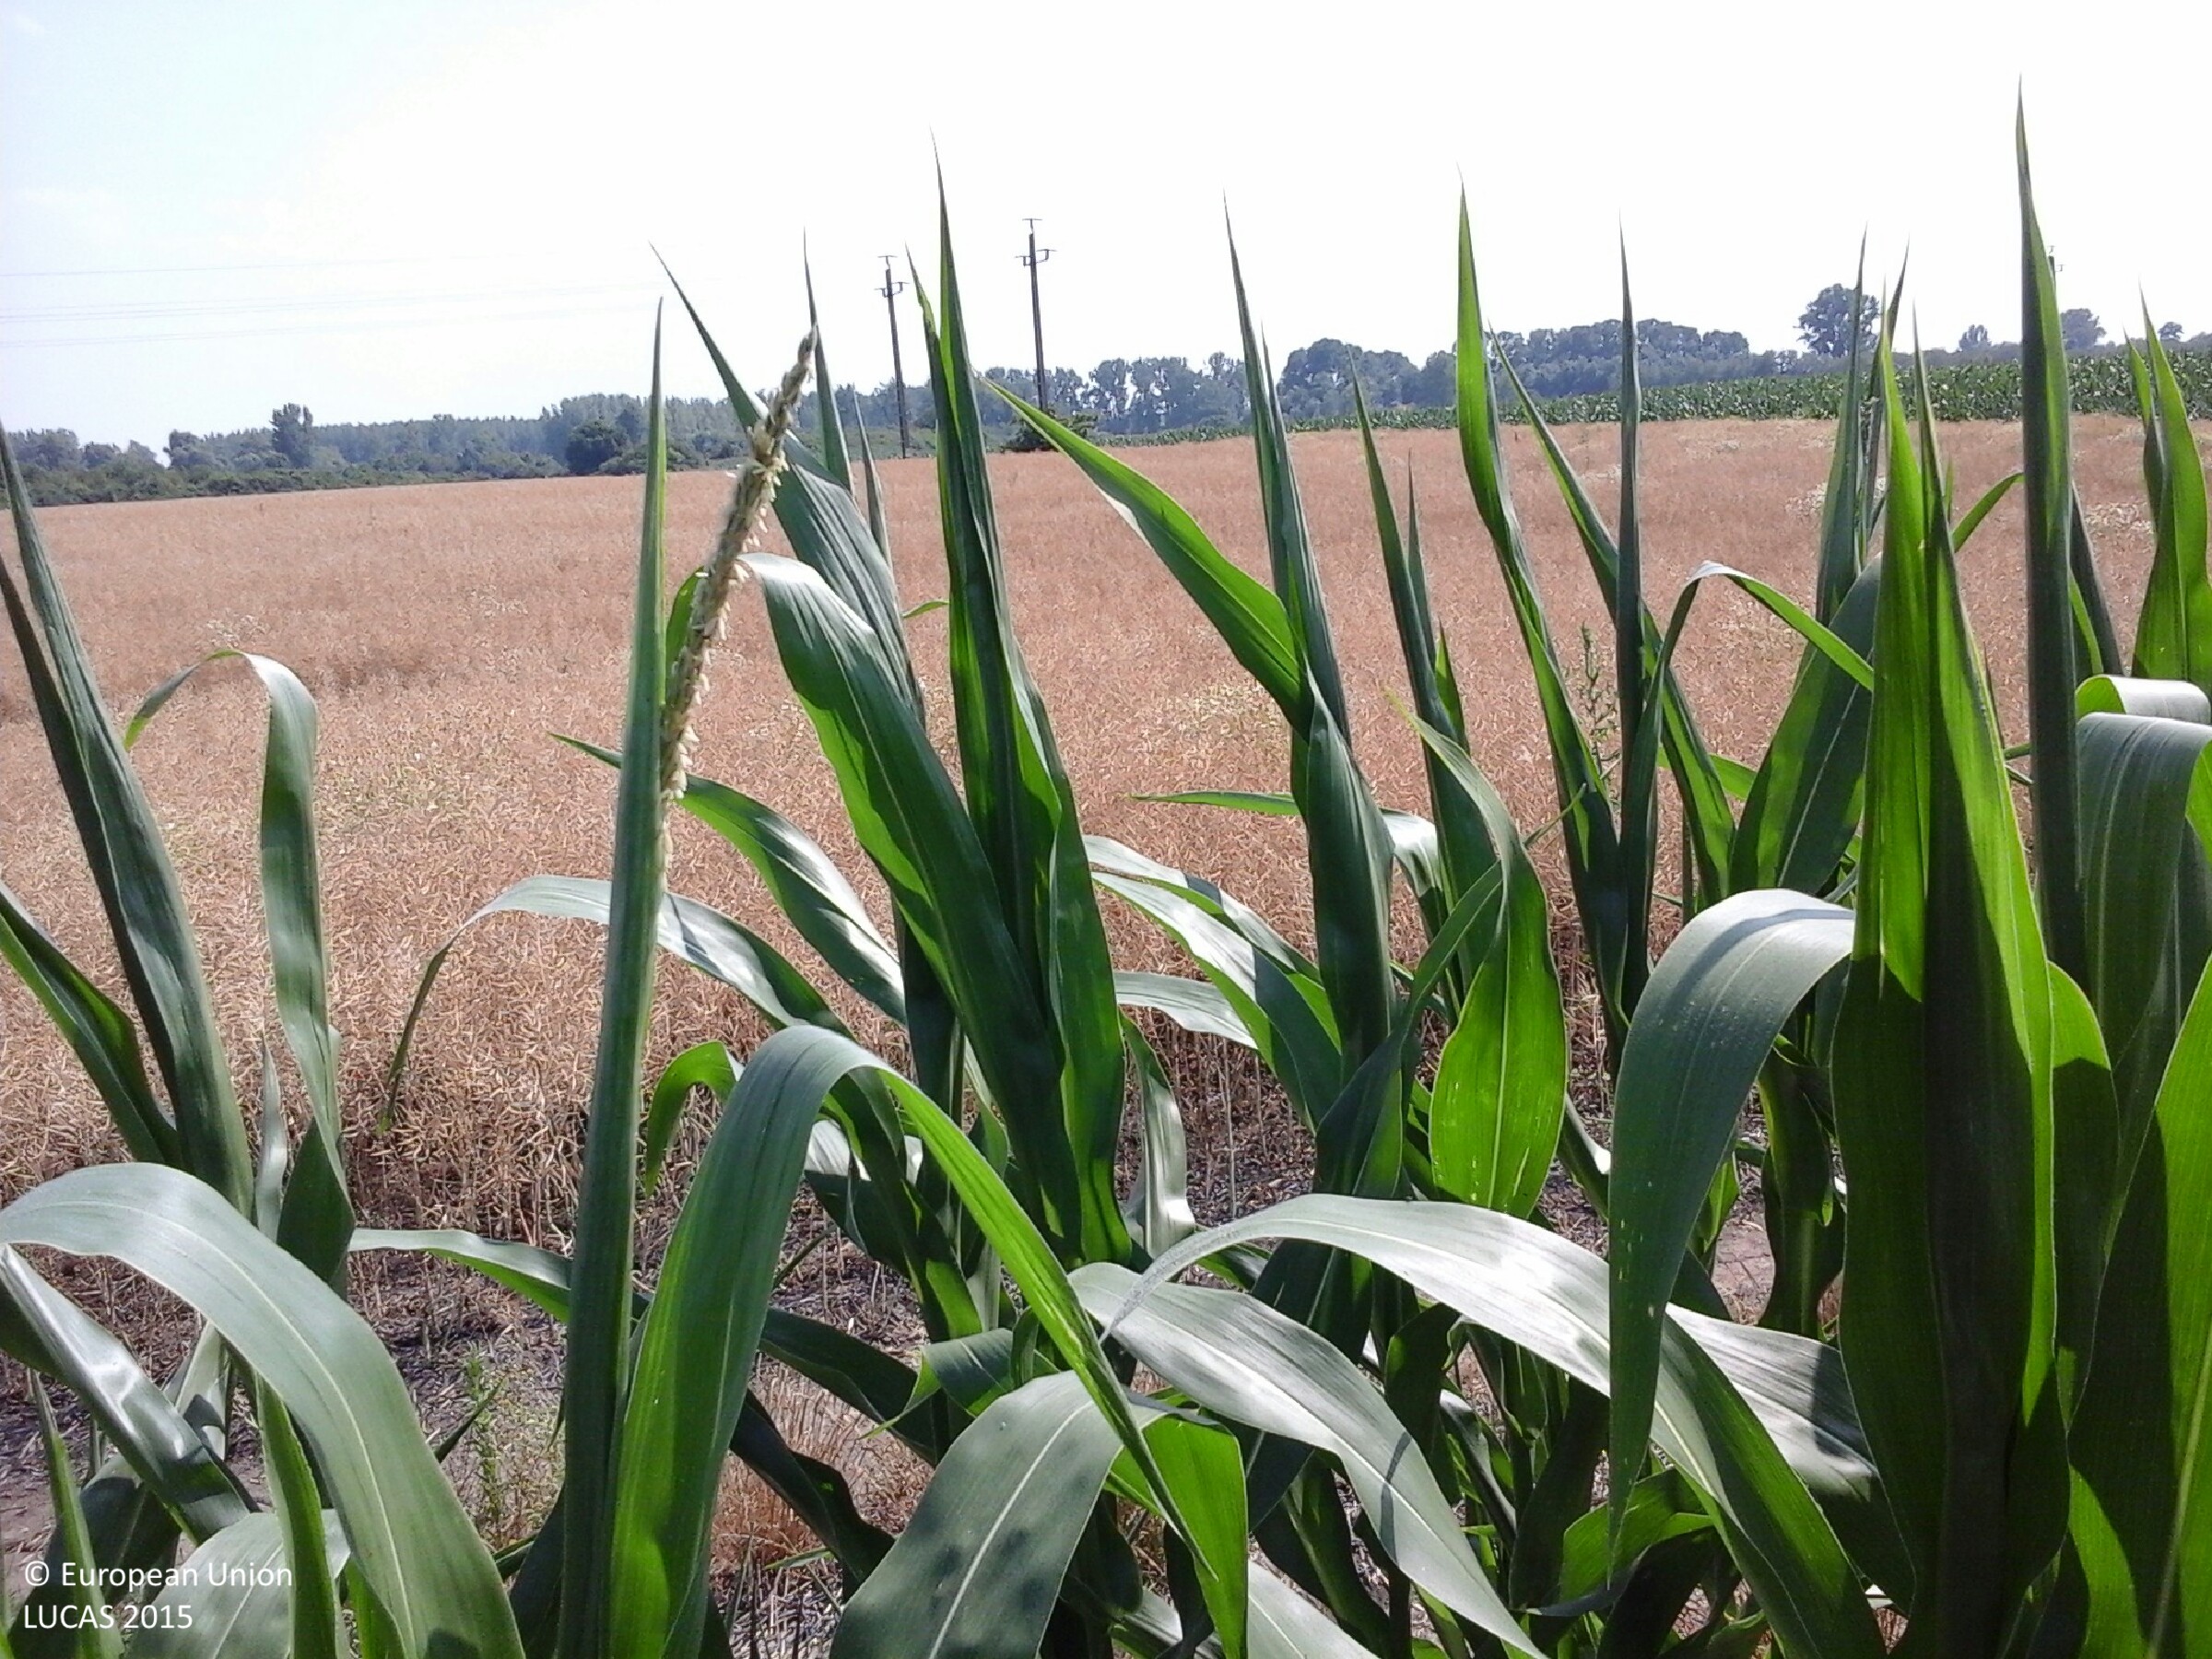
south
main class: Cropland
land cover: Maize
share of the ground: > 75 %
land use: Agriculture (excluding fallow land and kitchen gardens)
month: July
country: HU
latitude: 48.0402
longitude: 20.9431
